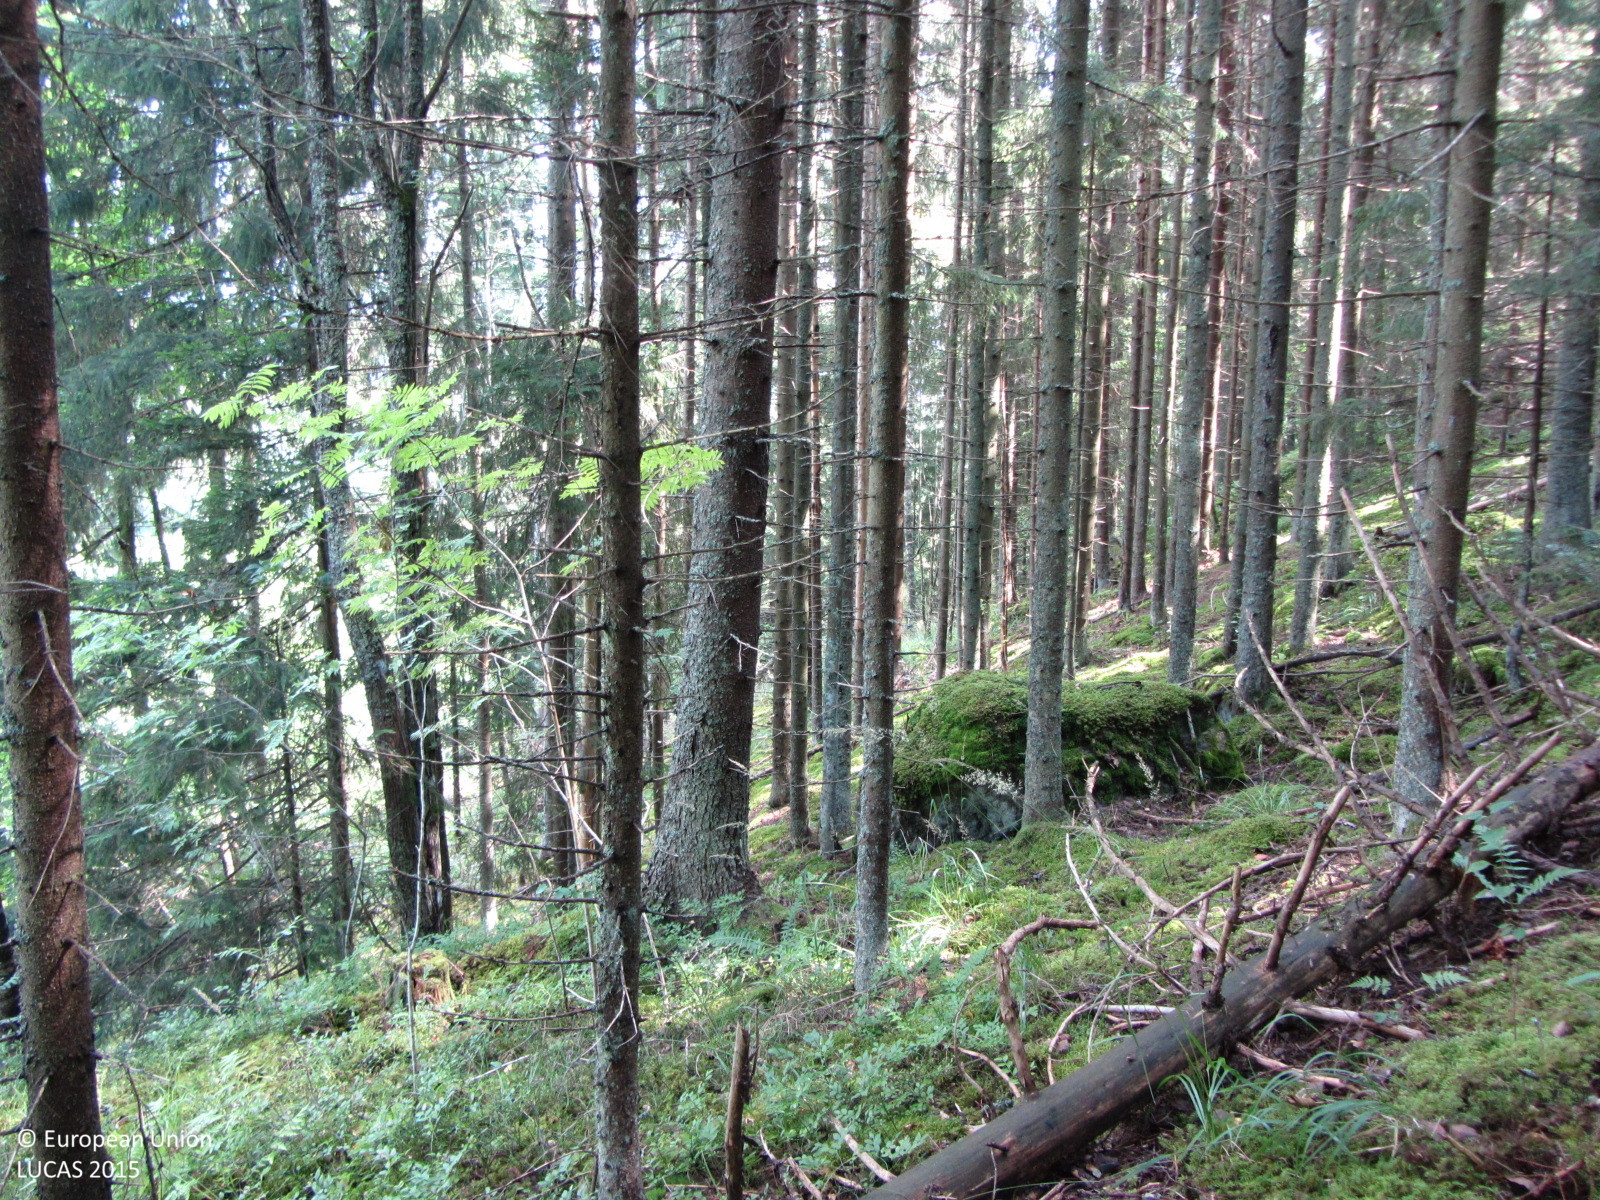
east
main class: Woodland
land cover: Spruce dominated mixed woodland
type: boreal forest
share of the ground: > 75 %
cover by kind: coniferous forest trees 50 %, broadleaved forest trees 40 %, shrubs 5 %, lichens and mosses 5 %
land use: Forestry
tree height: > 5 m
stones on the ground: < 10 %
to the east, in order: Spruce dominated mixed woodland; Ditches and canals; Grassland without tree/shrub cover; Spontaneously vegetated surfaces; Abandoned hedges; Ditches and canals; Spontaneously vegetated surfaces; Fences; Grassland without tree/shrub cover; Ditches and canals; Grassland without tree/shrub cover
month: August
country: FI
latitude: 60.1918
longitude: 24.1871
